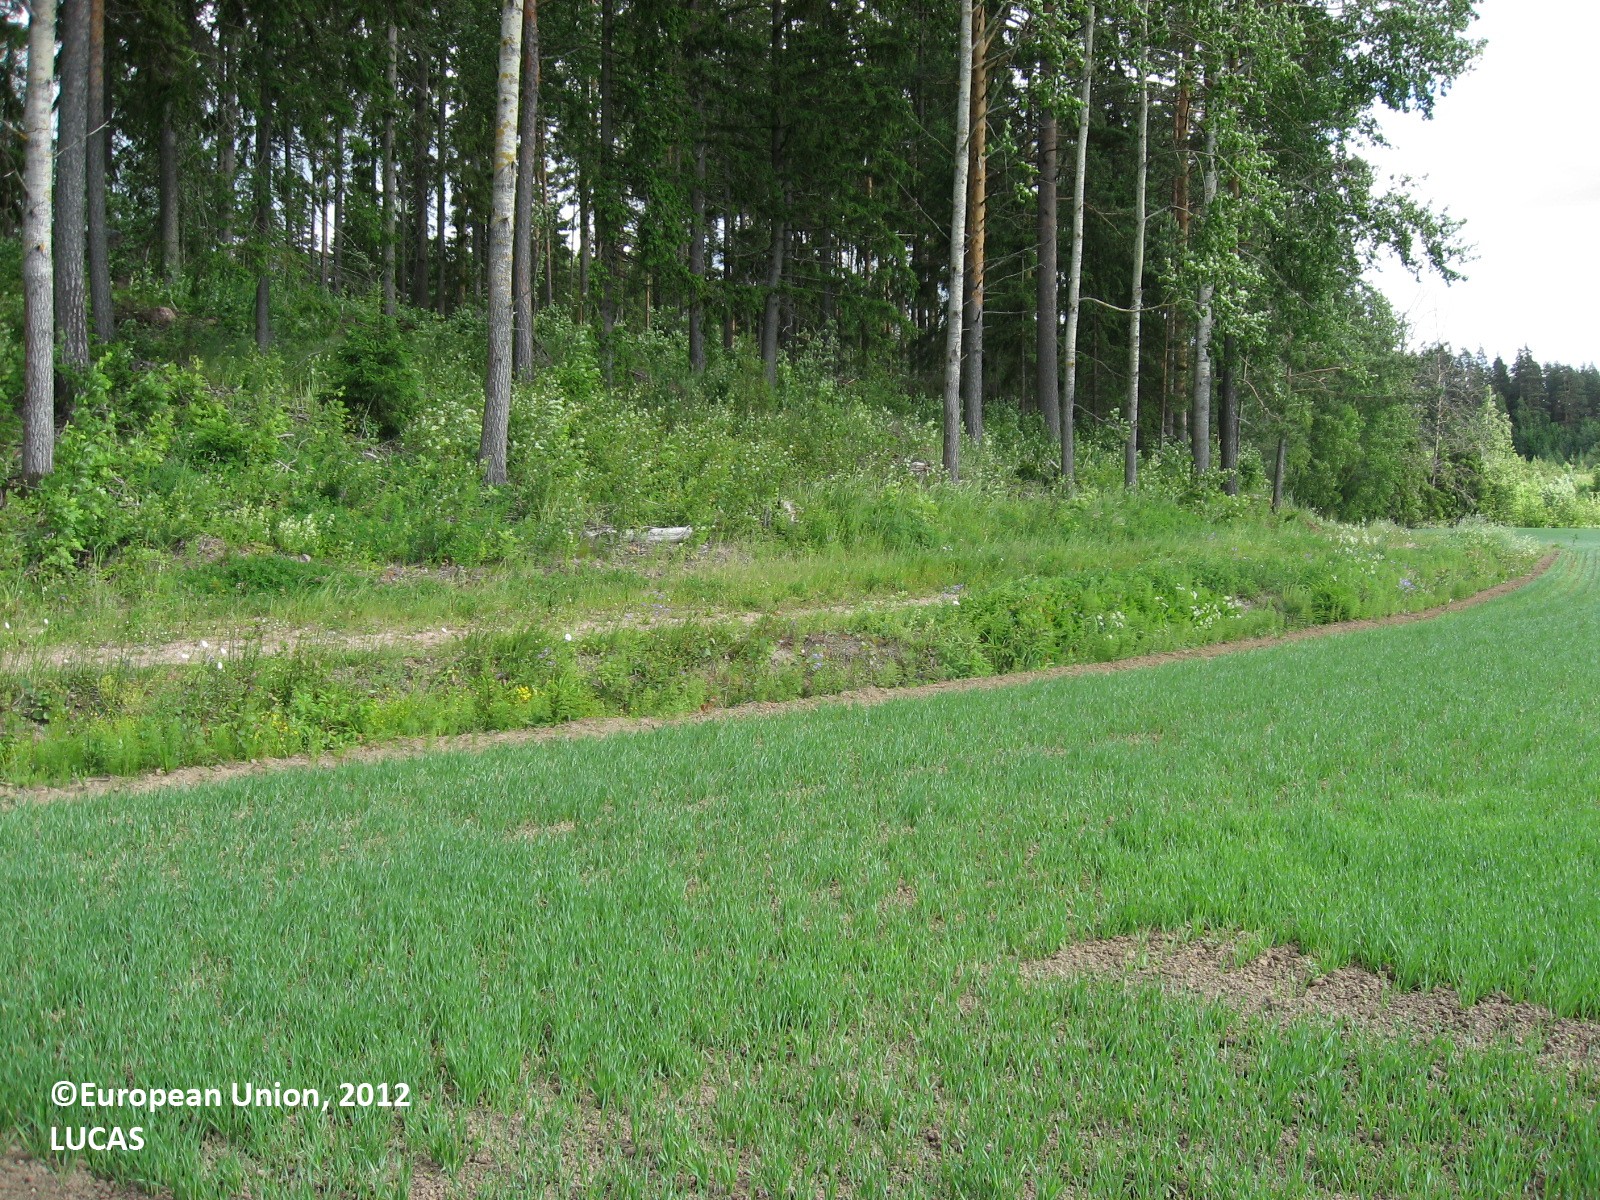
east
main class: Cropland
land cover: Temporary grasslands
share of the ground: > 75 %
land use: Agriculture (excluding fallow land and kitchen gardens)
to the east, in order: Temporary grasslands; Barley; Ditches and canals; Grass margins; Tracks; Spruce dominated mixed woodland
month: June
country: FI
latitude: 60.6187
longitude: 26.5091
